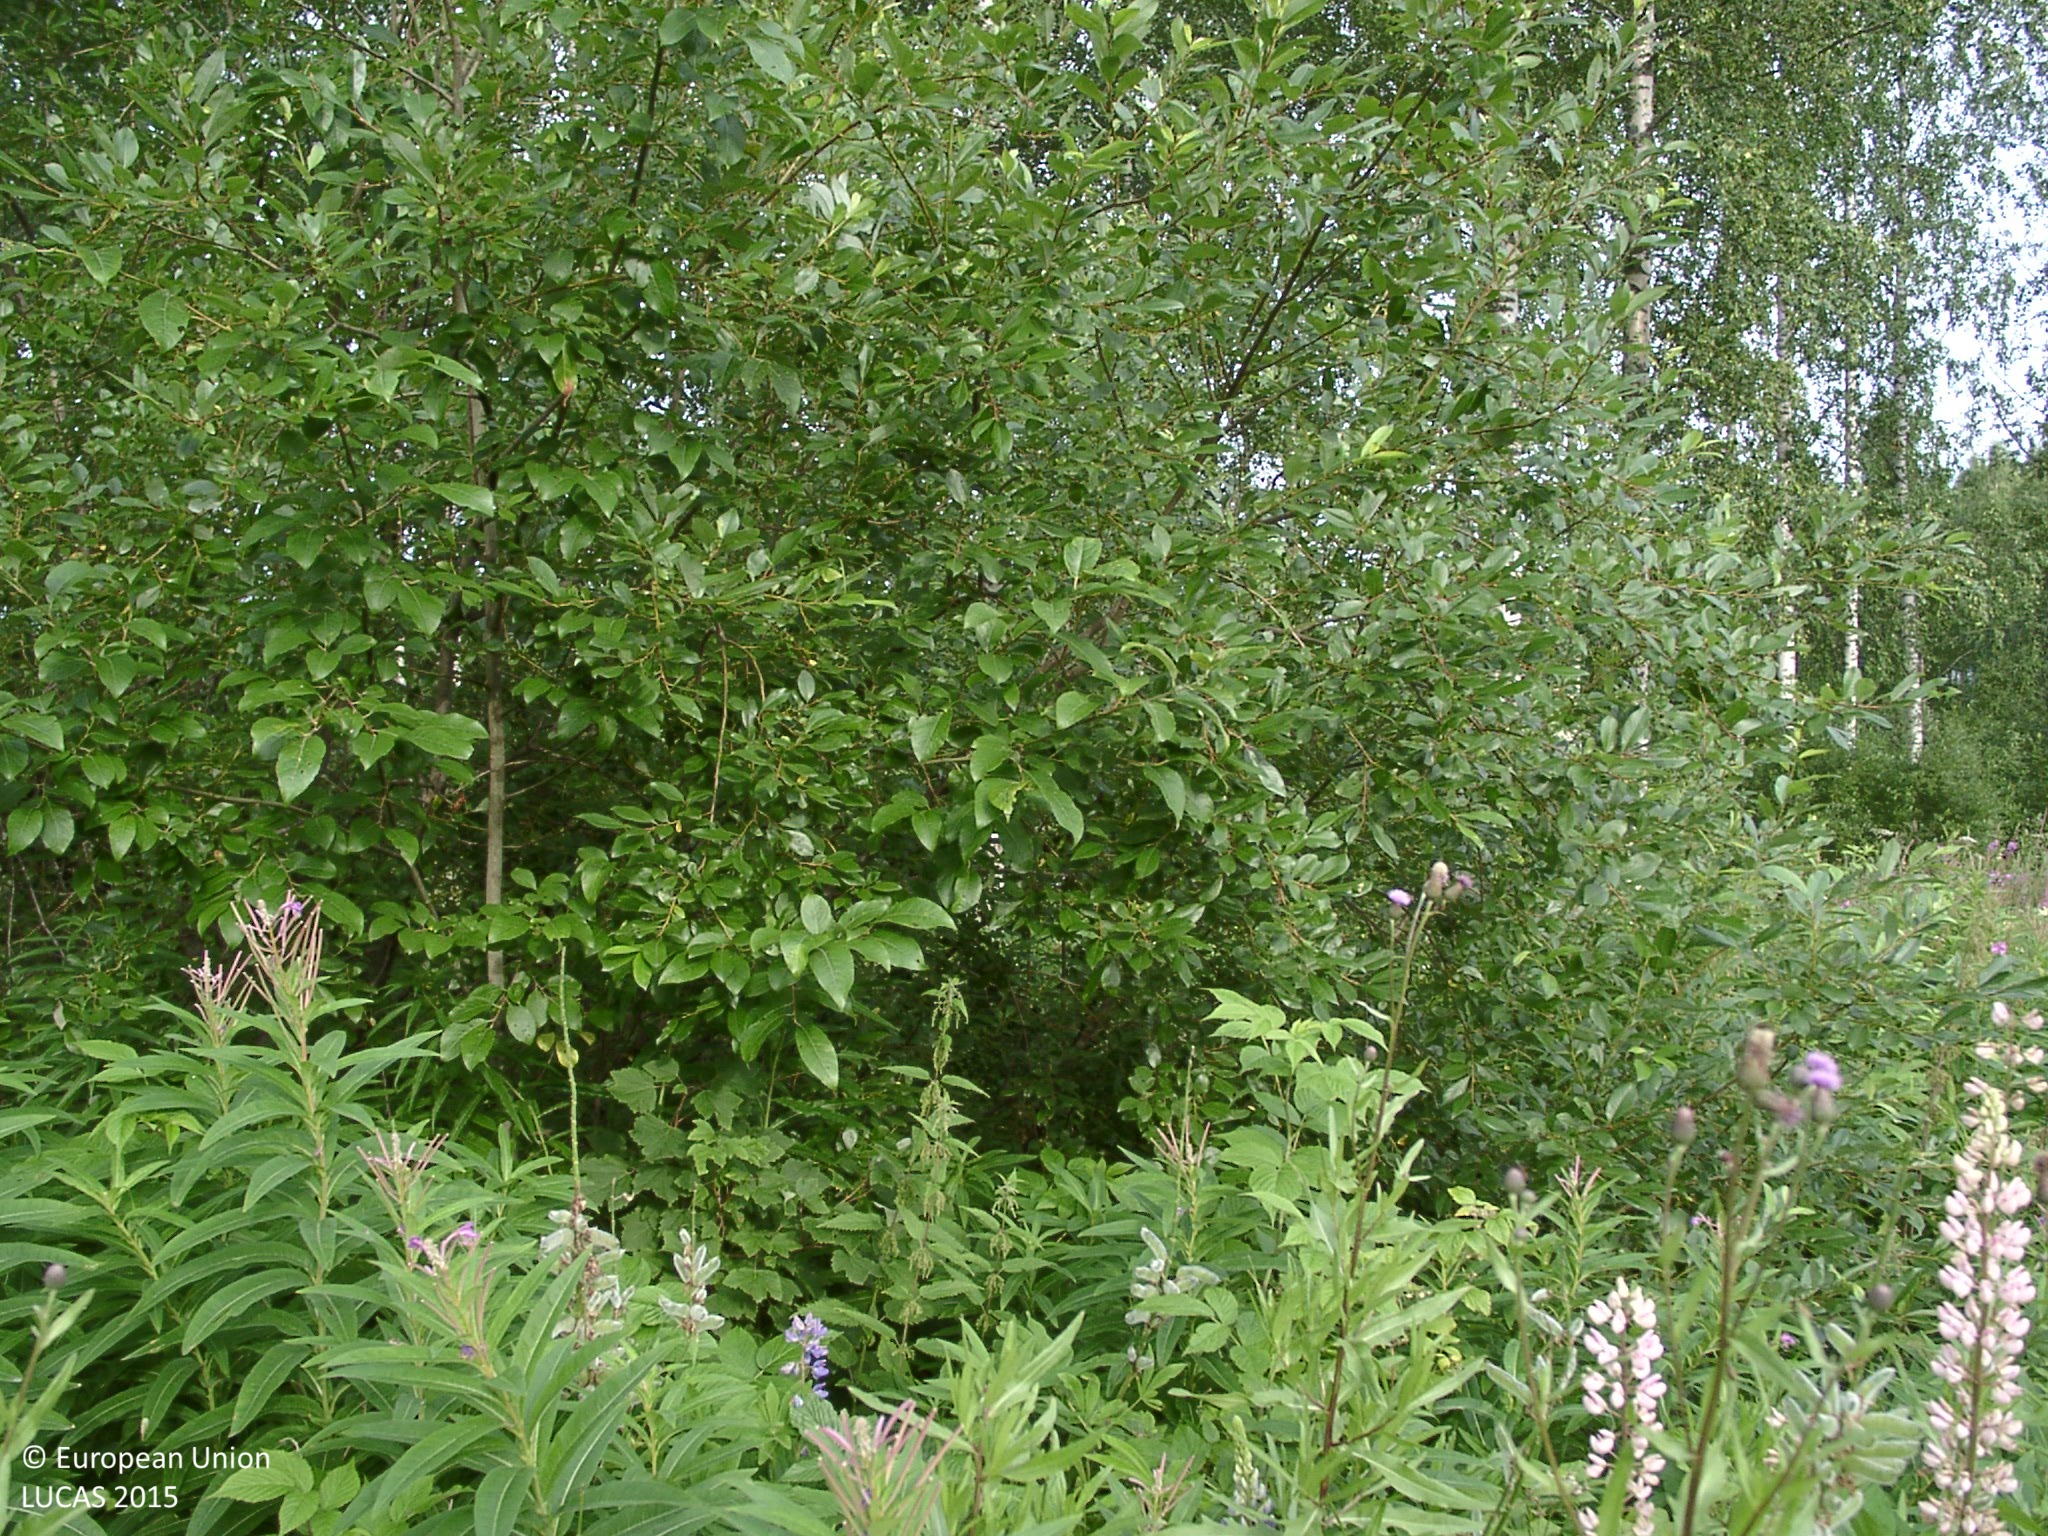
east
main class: Grassland
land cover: Grassland without tree/shrub cover
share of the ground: > 75 %
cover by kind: herbaceous plants 95 %, shrubs 5 %
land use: Road transport
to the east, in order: Grassland without tree/shrub cover; Broadleaved woodland; Tracks; Broadleaved woodland; Inland fresh water bodies
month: July
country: FI
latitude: 62.2958
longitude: 25.7173
